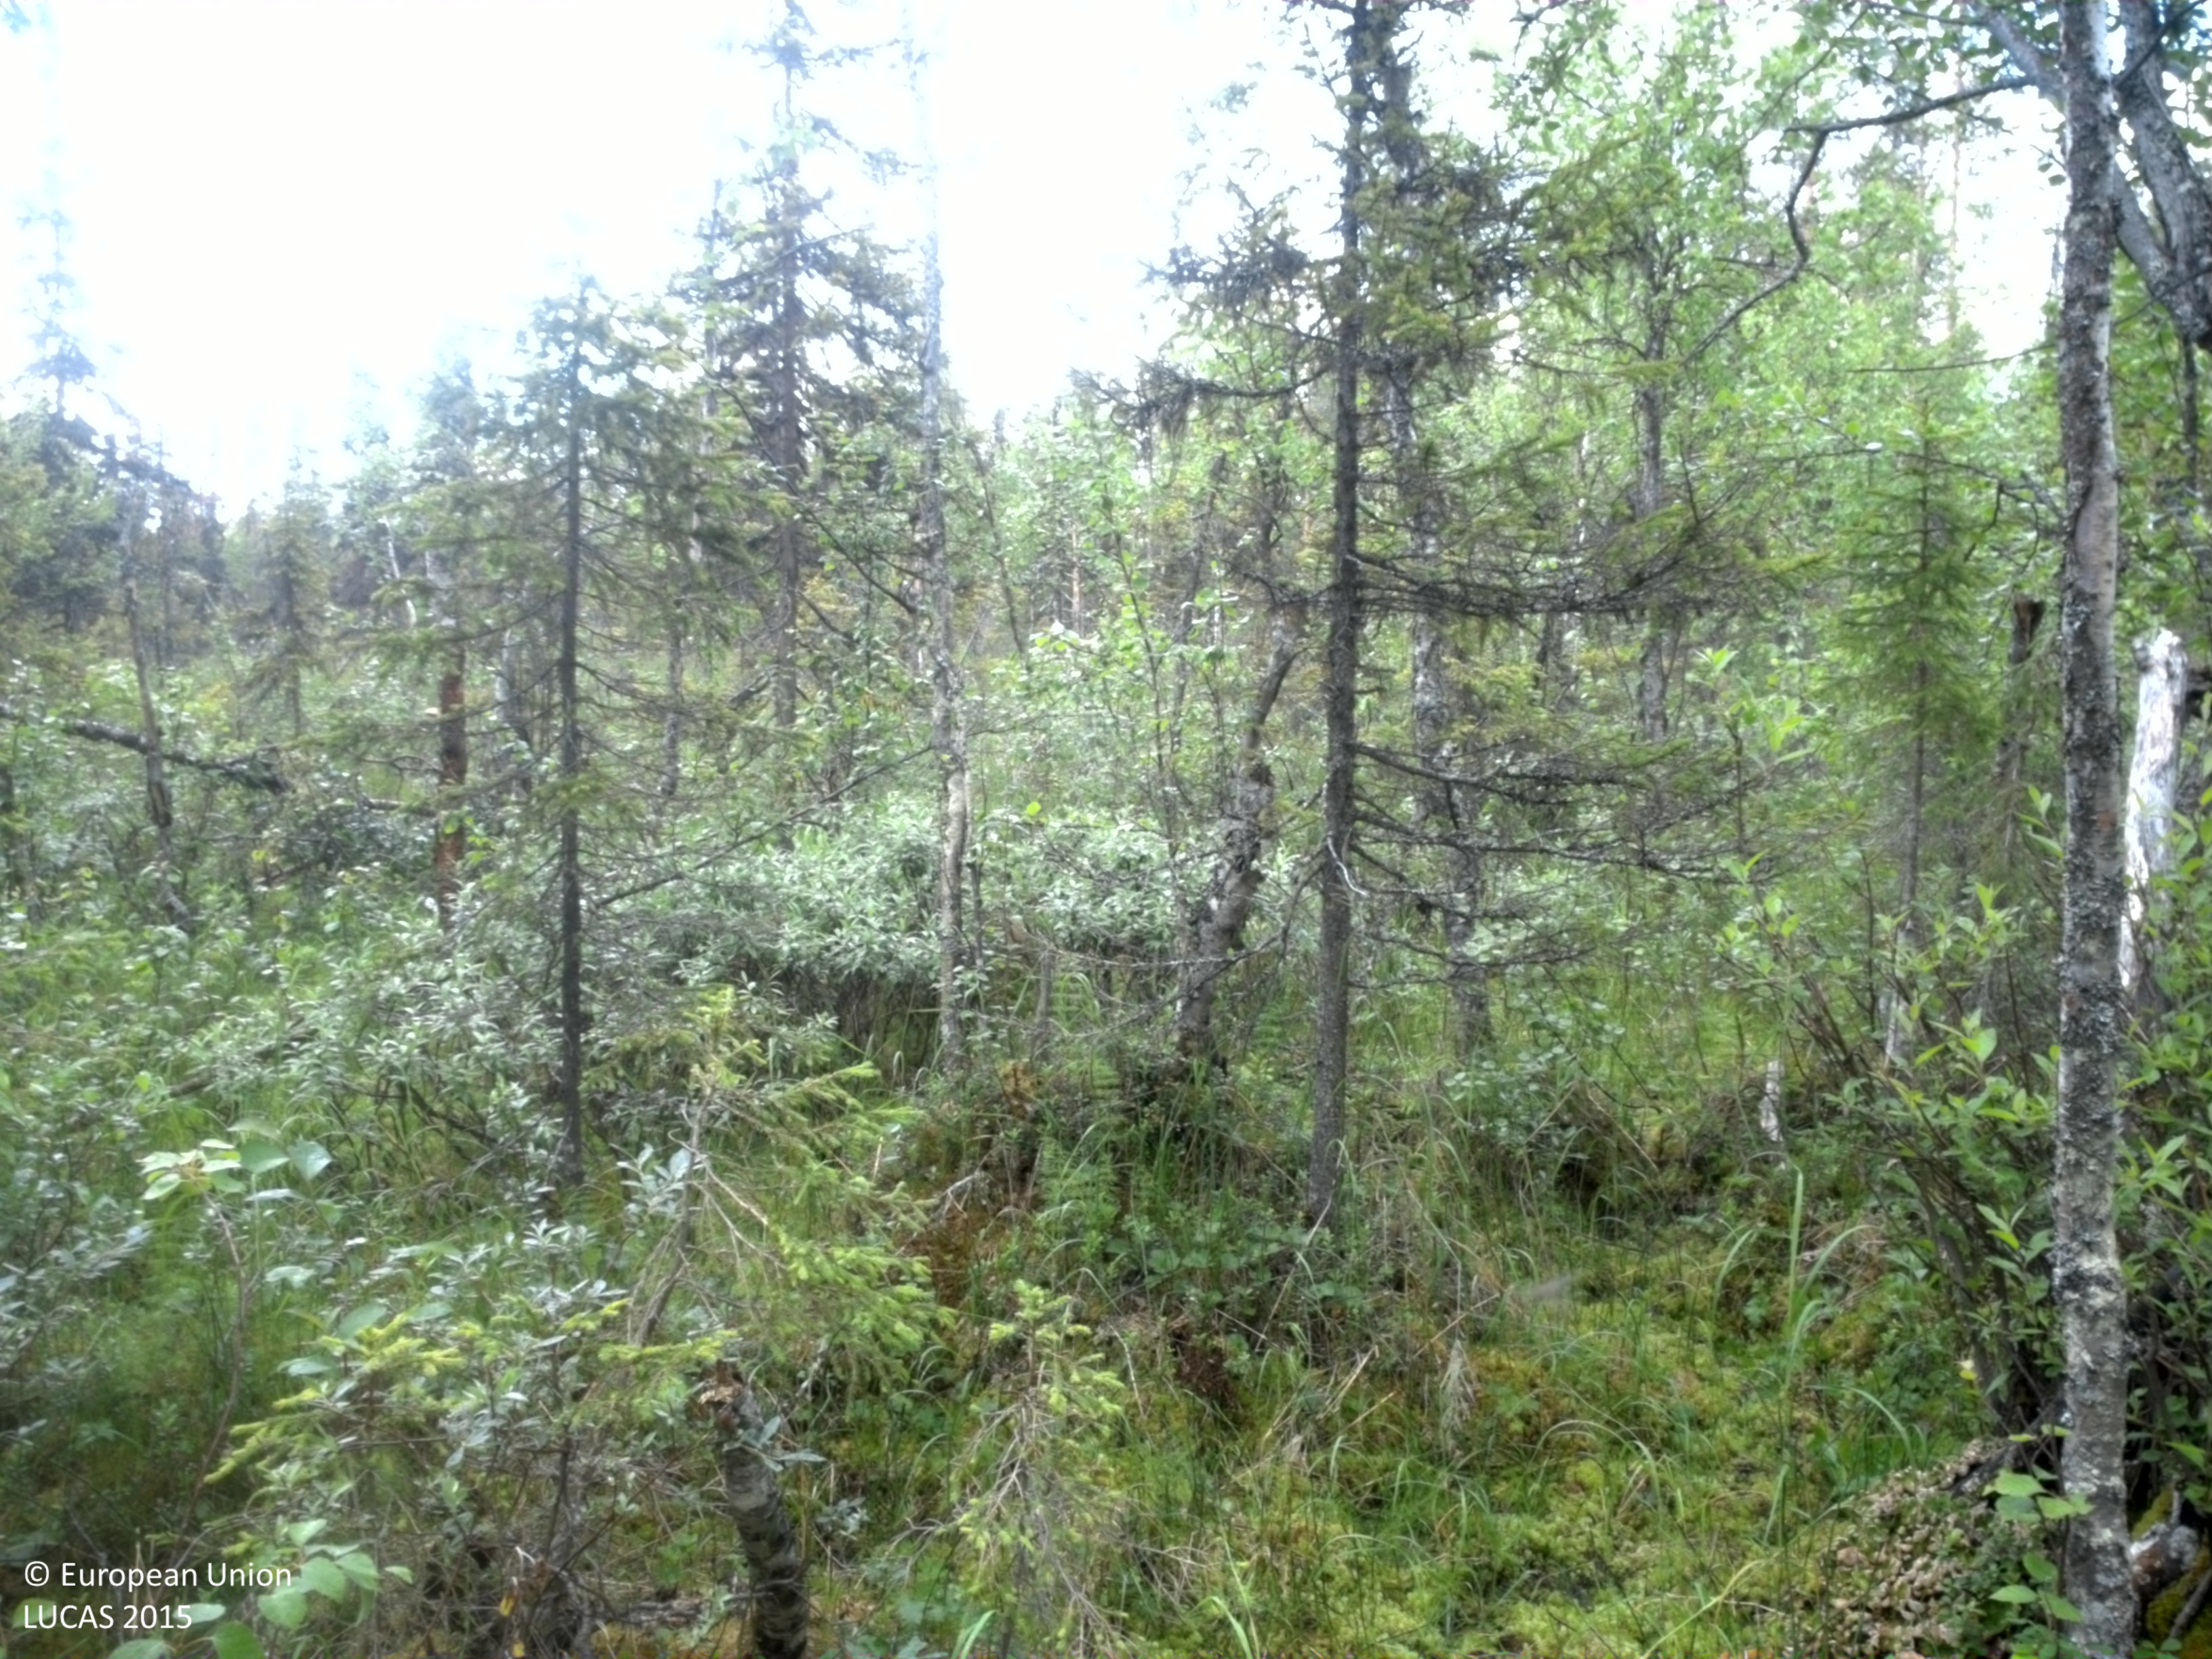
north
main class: Woodland
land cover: Spruce dominated mixed woodland
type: mire and swamp forests
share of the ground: 25 - 50 %
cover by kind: shrubs 45 %, coniferous forest trees 25 %, broadleaved forest trees 15 %, lichens and mosses 10 %, herbaceous plants 5 %
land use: Semi-natural and natural areas not in use
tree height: > 5 m
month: July
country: SE
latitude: 66.4246
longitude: 19.5657
